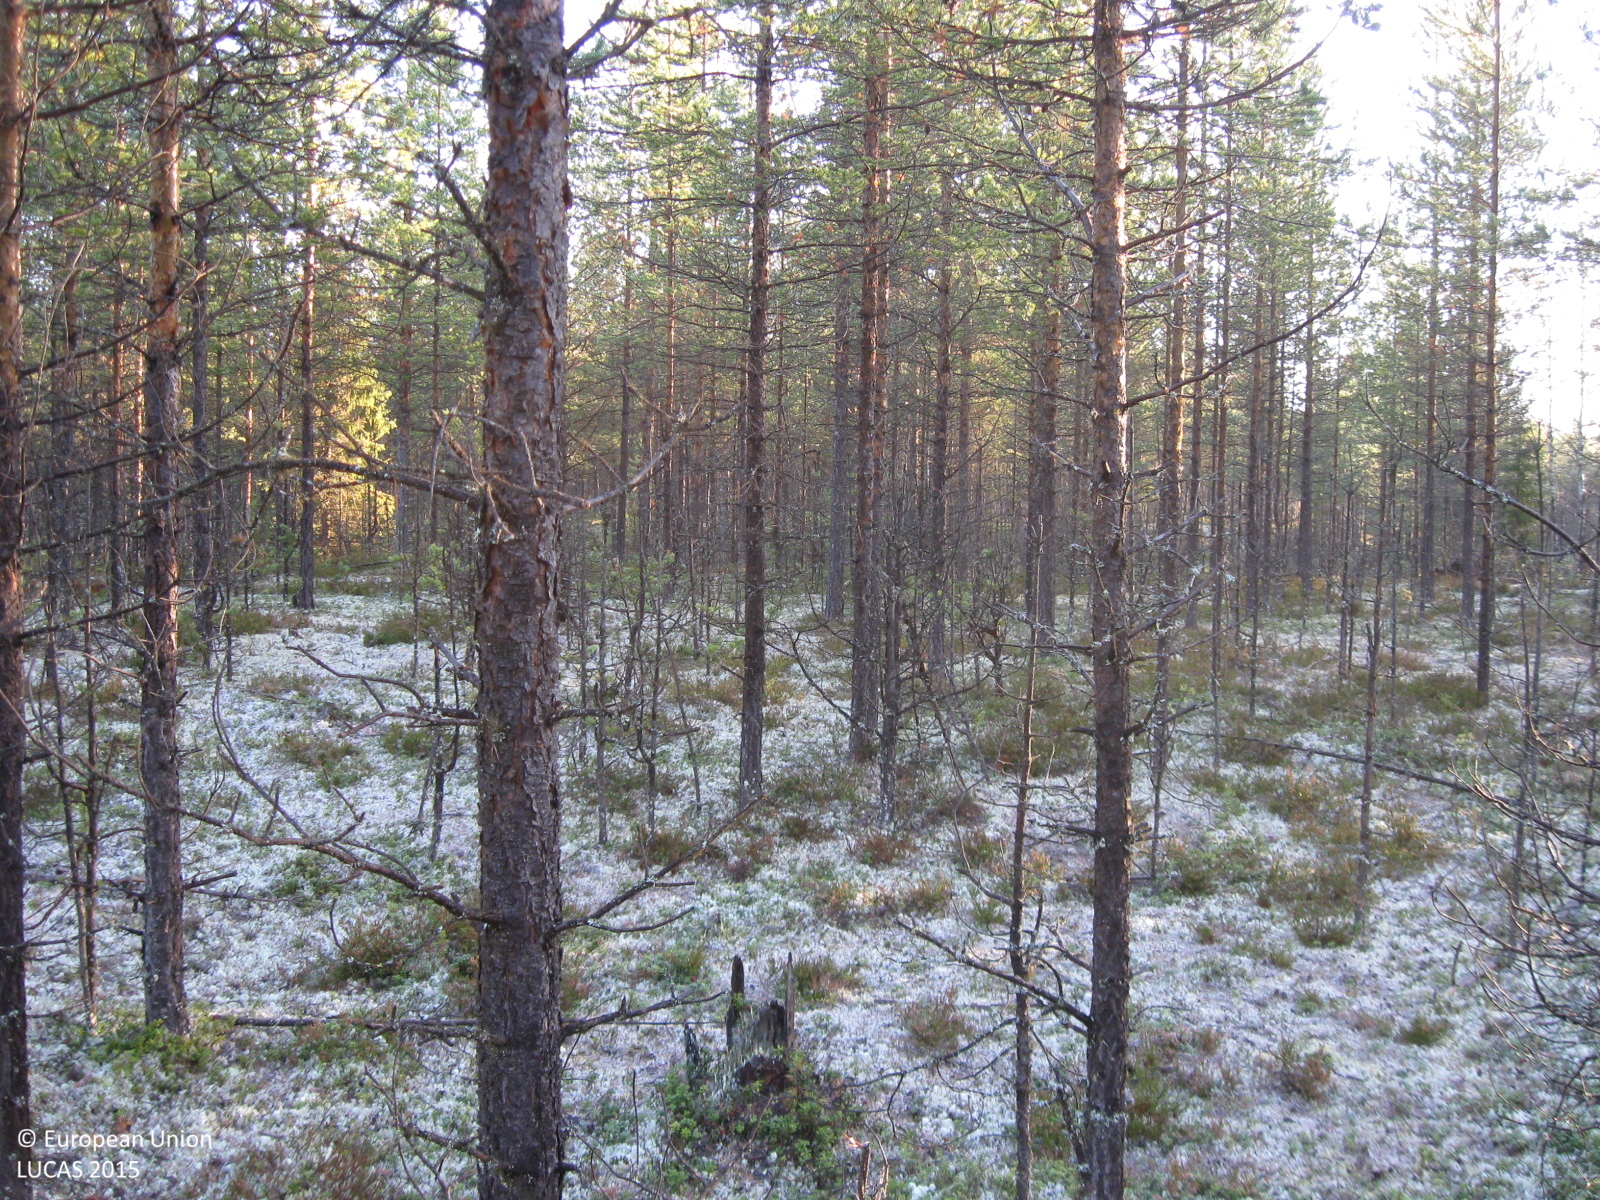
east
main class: Woodland
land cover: Pine dominated coniferous woodland
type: boreal forest
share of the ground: 50 - 75 %
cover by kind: coniferous forest trees 55 %, lichens and mosses 30 %, shrubs 10 %, herbaceous plants 5 %
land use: Forestry
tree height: > 5 m
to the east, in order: Pine dominated coniferous woodland; Broadleaved woodland; Pine dominated coniferous woodland
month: October
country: SE
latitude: 66.2738
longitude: 20.8518
